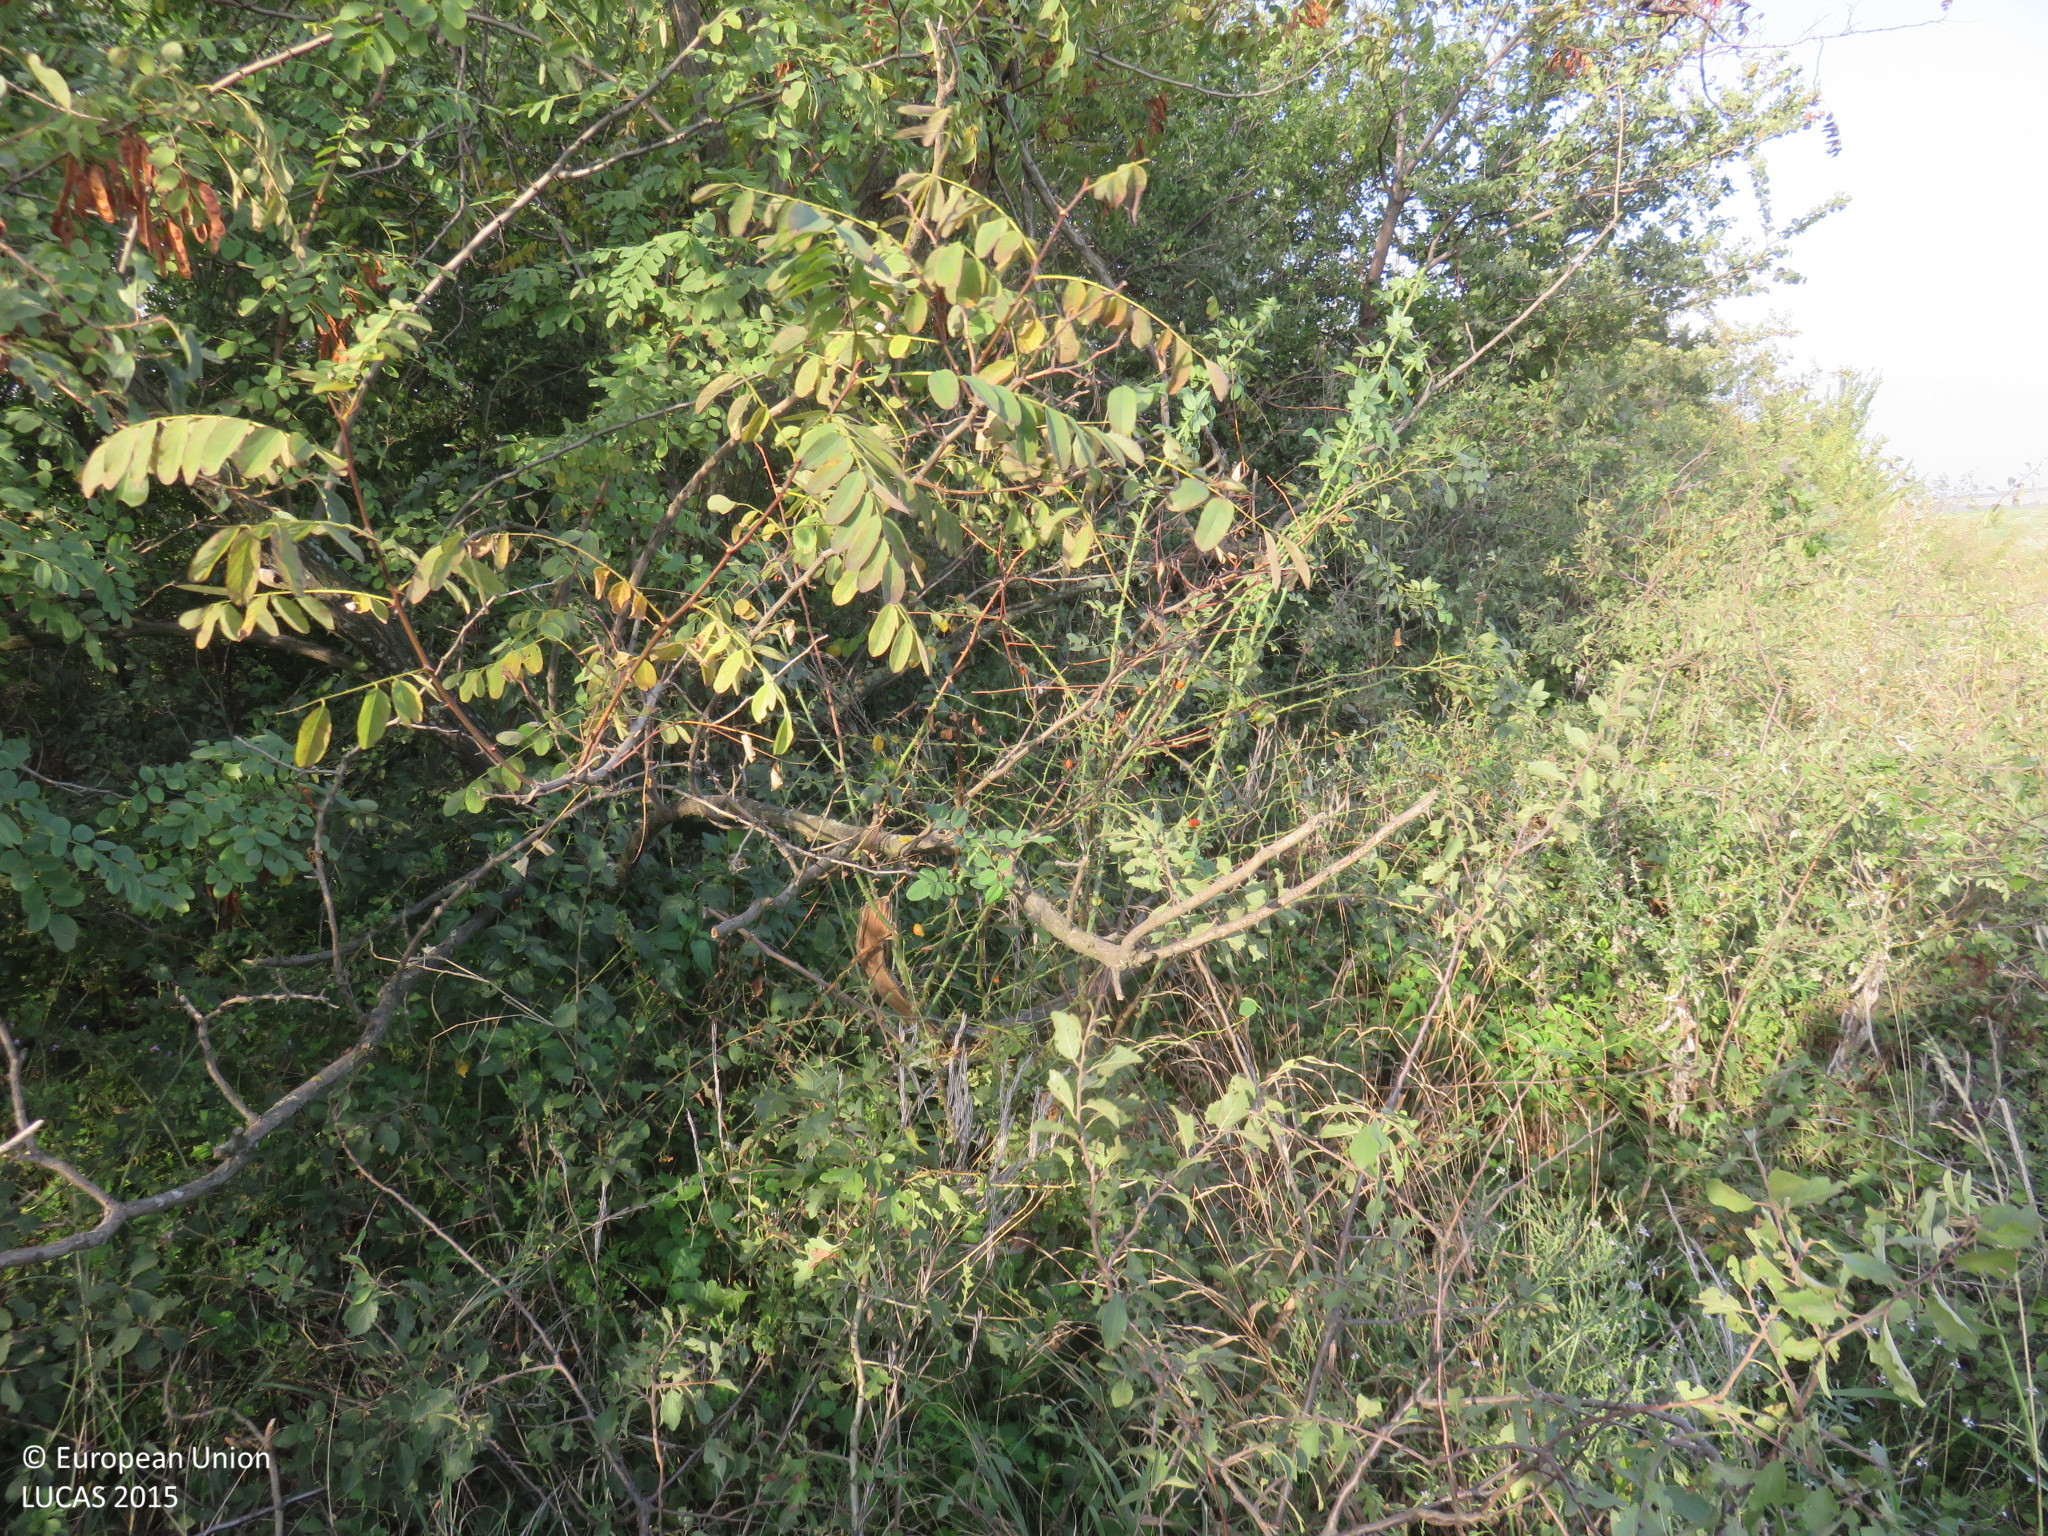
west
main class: Woodland
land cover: Broadleaved woodland
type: mesophytic deciduous forest
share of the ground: > 75 %
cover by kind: broadleaved forest trees 80 %, shrubs 15 %, herbaceous plants 5 %
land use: Forestry
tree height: < 5 m
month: September
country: BG
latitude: 43.5621
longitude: 25.0150
